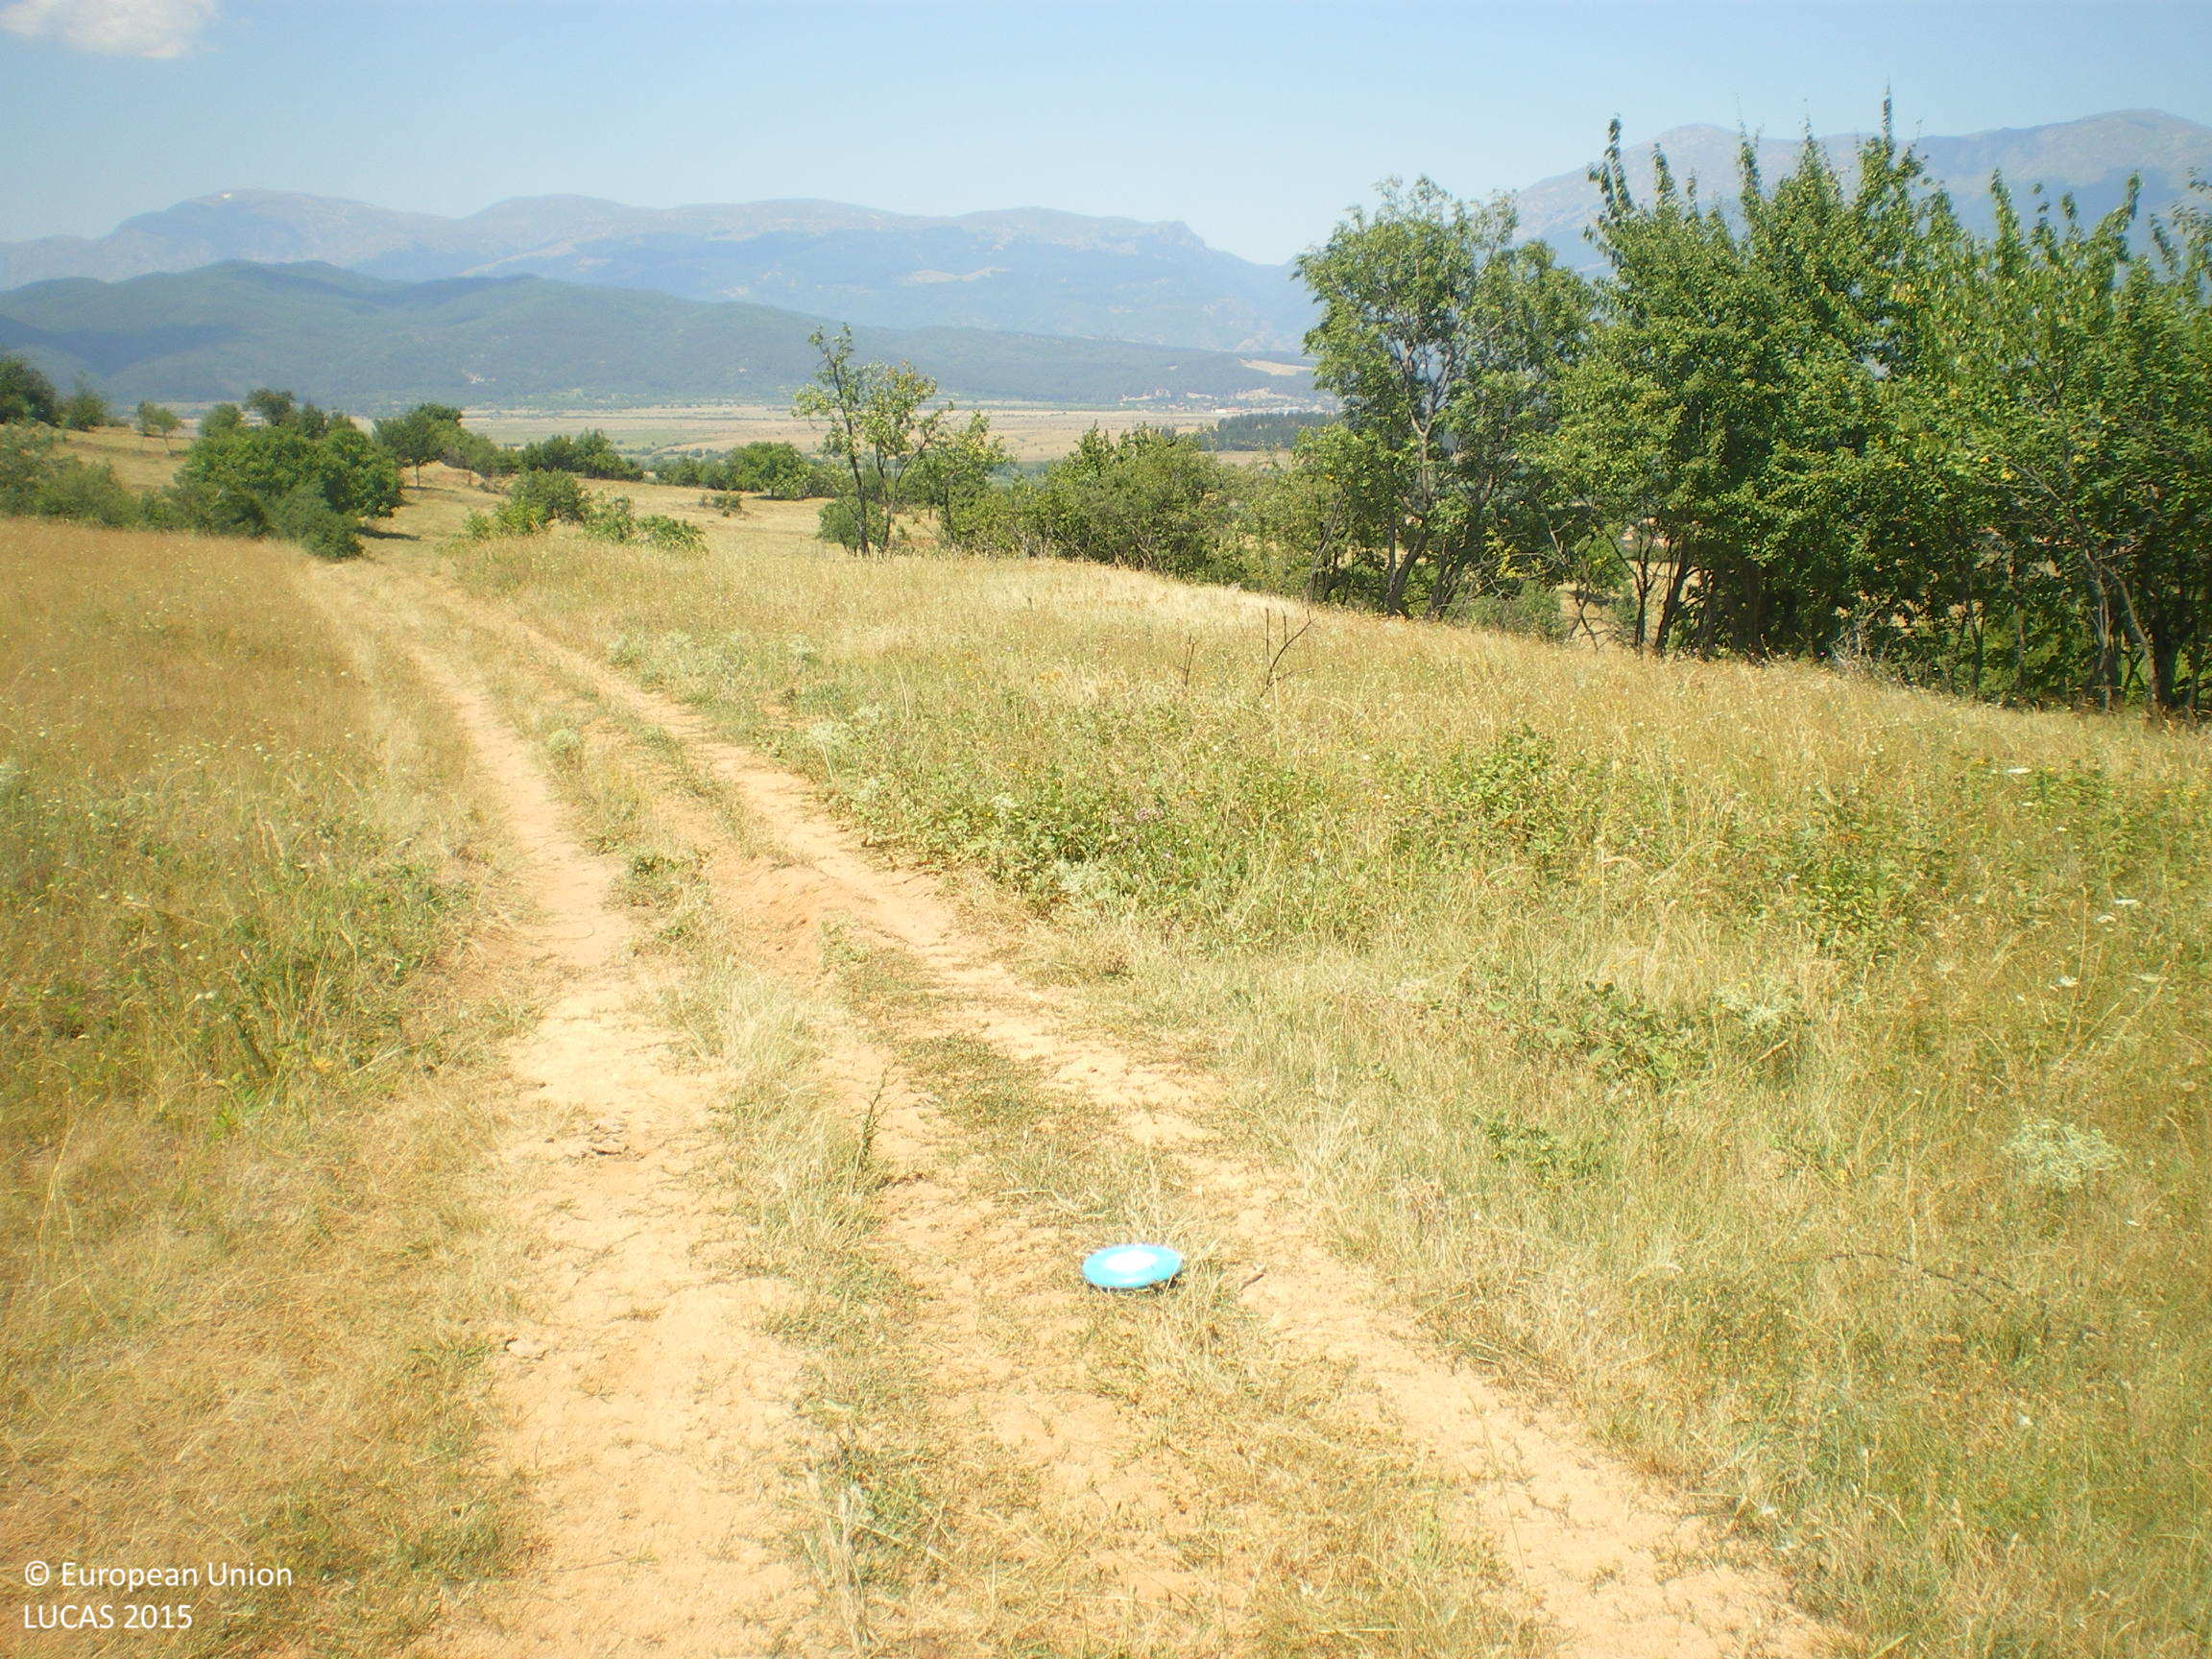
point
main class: Grassland
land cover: Grassland without tree/shrub cover
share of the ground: > 75 %
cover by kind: herbaceous plants 100 %
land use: Agriculture (excluding fallow land and kitchen gardens)
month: July
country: BG
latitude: 42.5802
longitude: 25.0858
